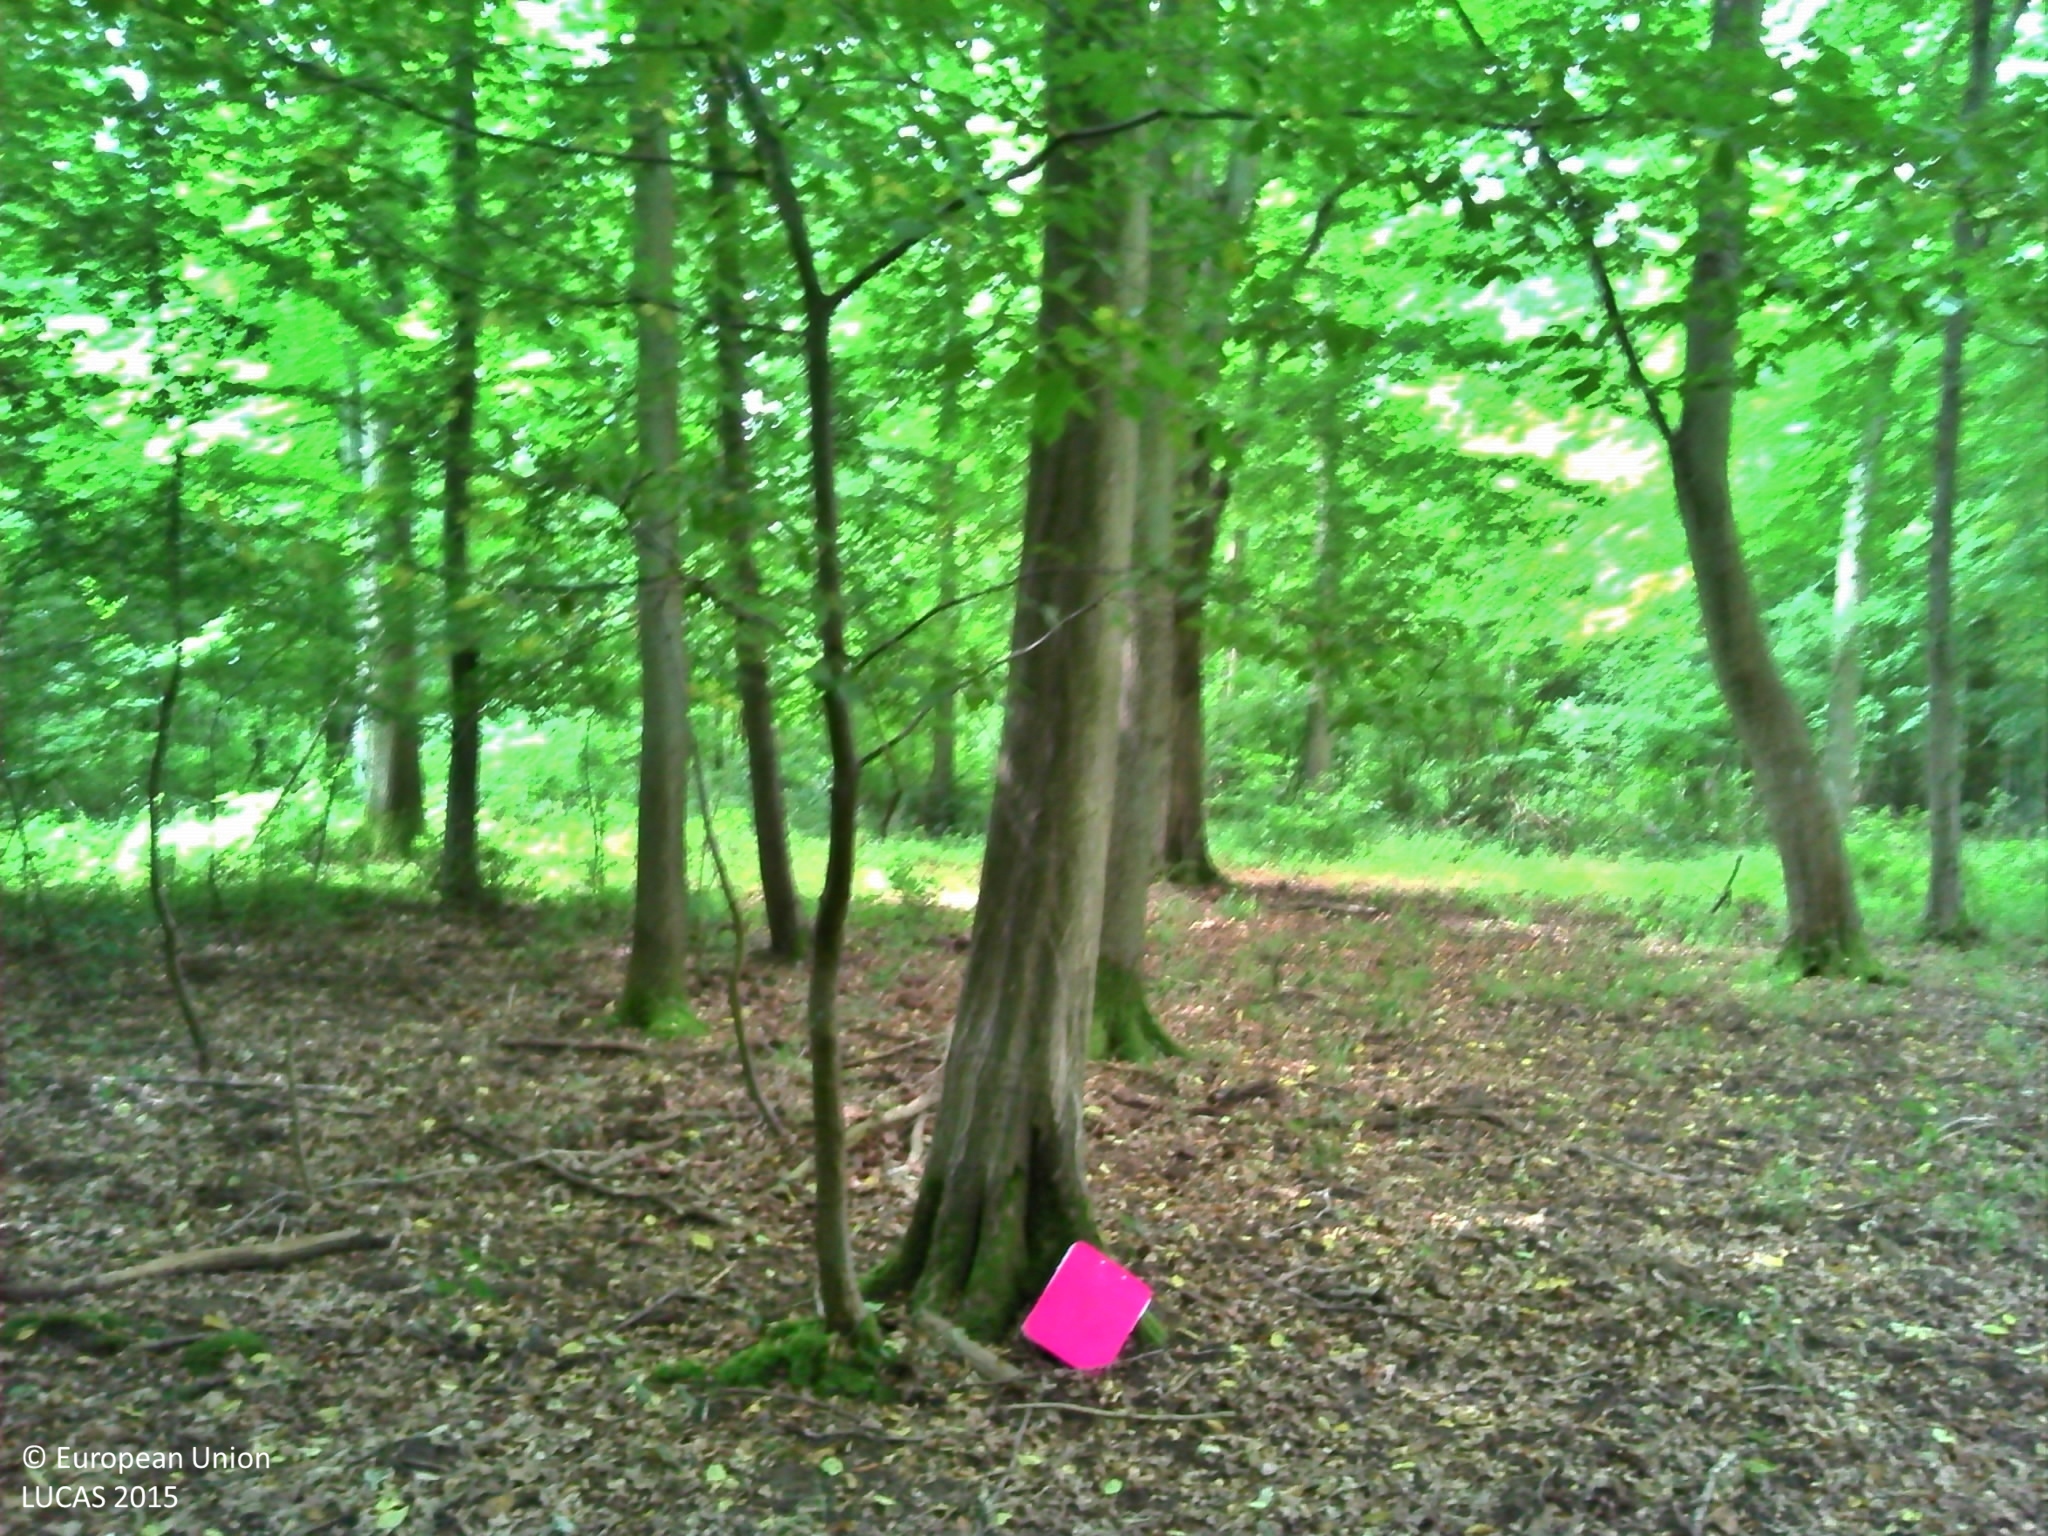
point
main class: Woodland
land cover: Broadleaved woodland
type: acidophilous oak and oak-birch forest
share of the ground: > 75 %
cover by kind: broadleaved forest trees 85 %, herbaceous plants 10 %, unconsolidated bare surface 5 %
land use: Forestry
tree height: > 5 m
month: July
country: FR
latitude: 49.1847
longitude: 2.5939
